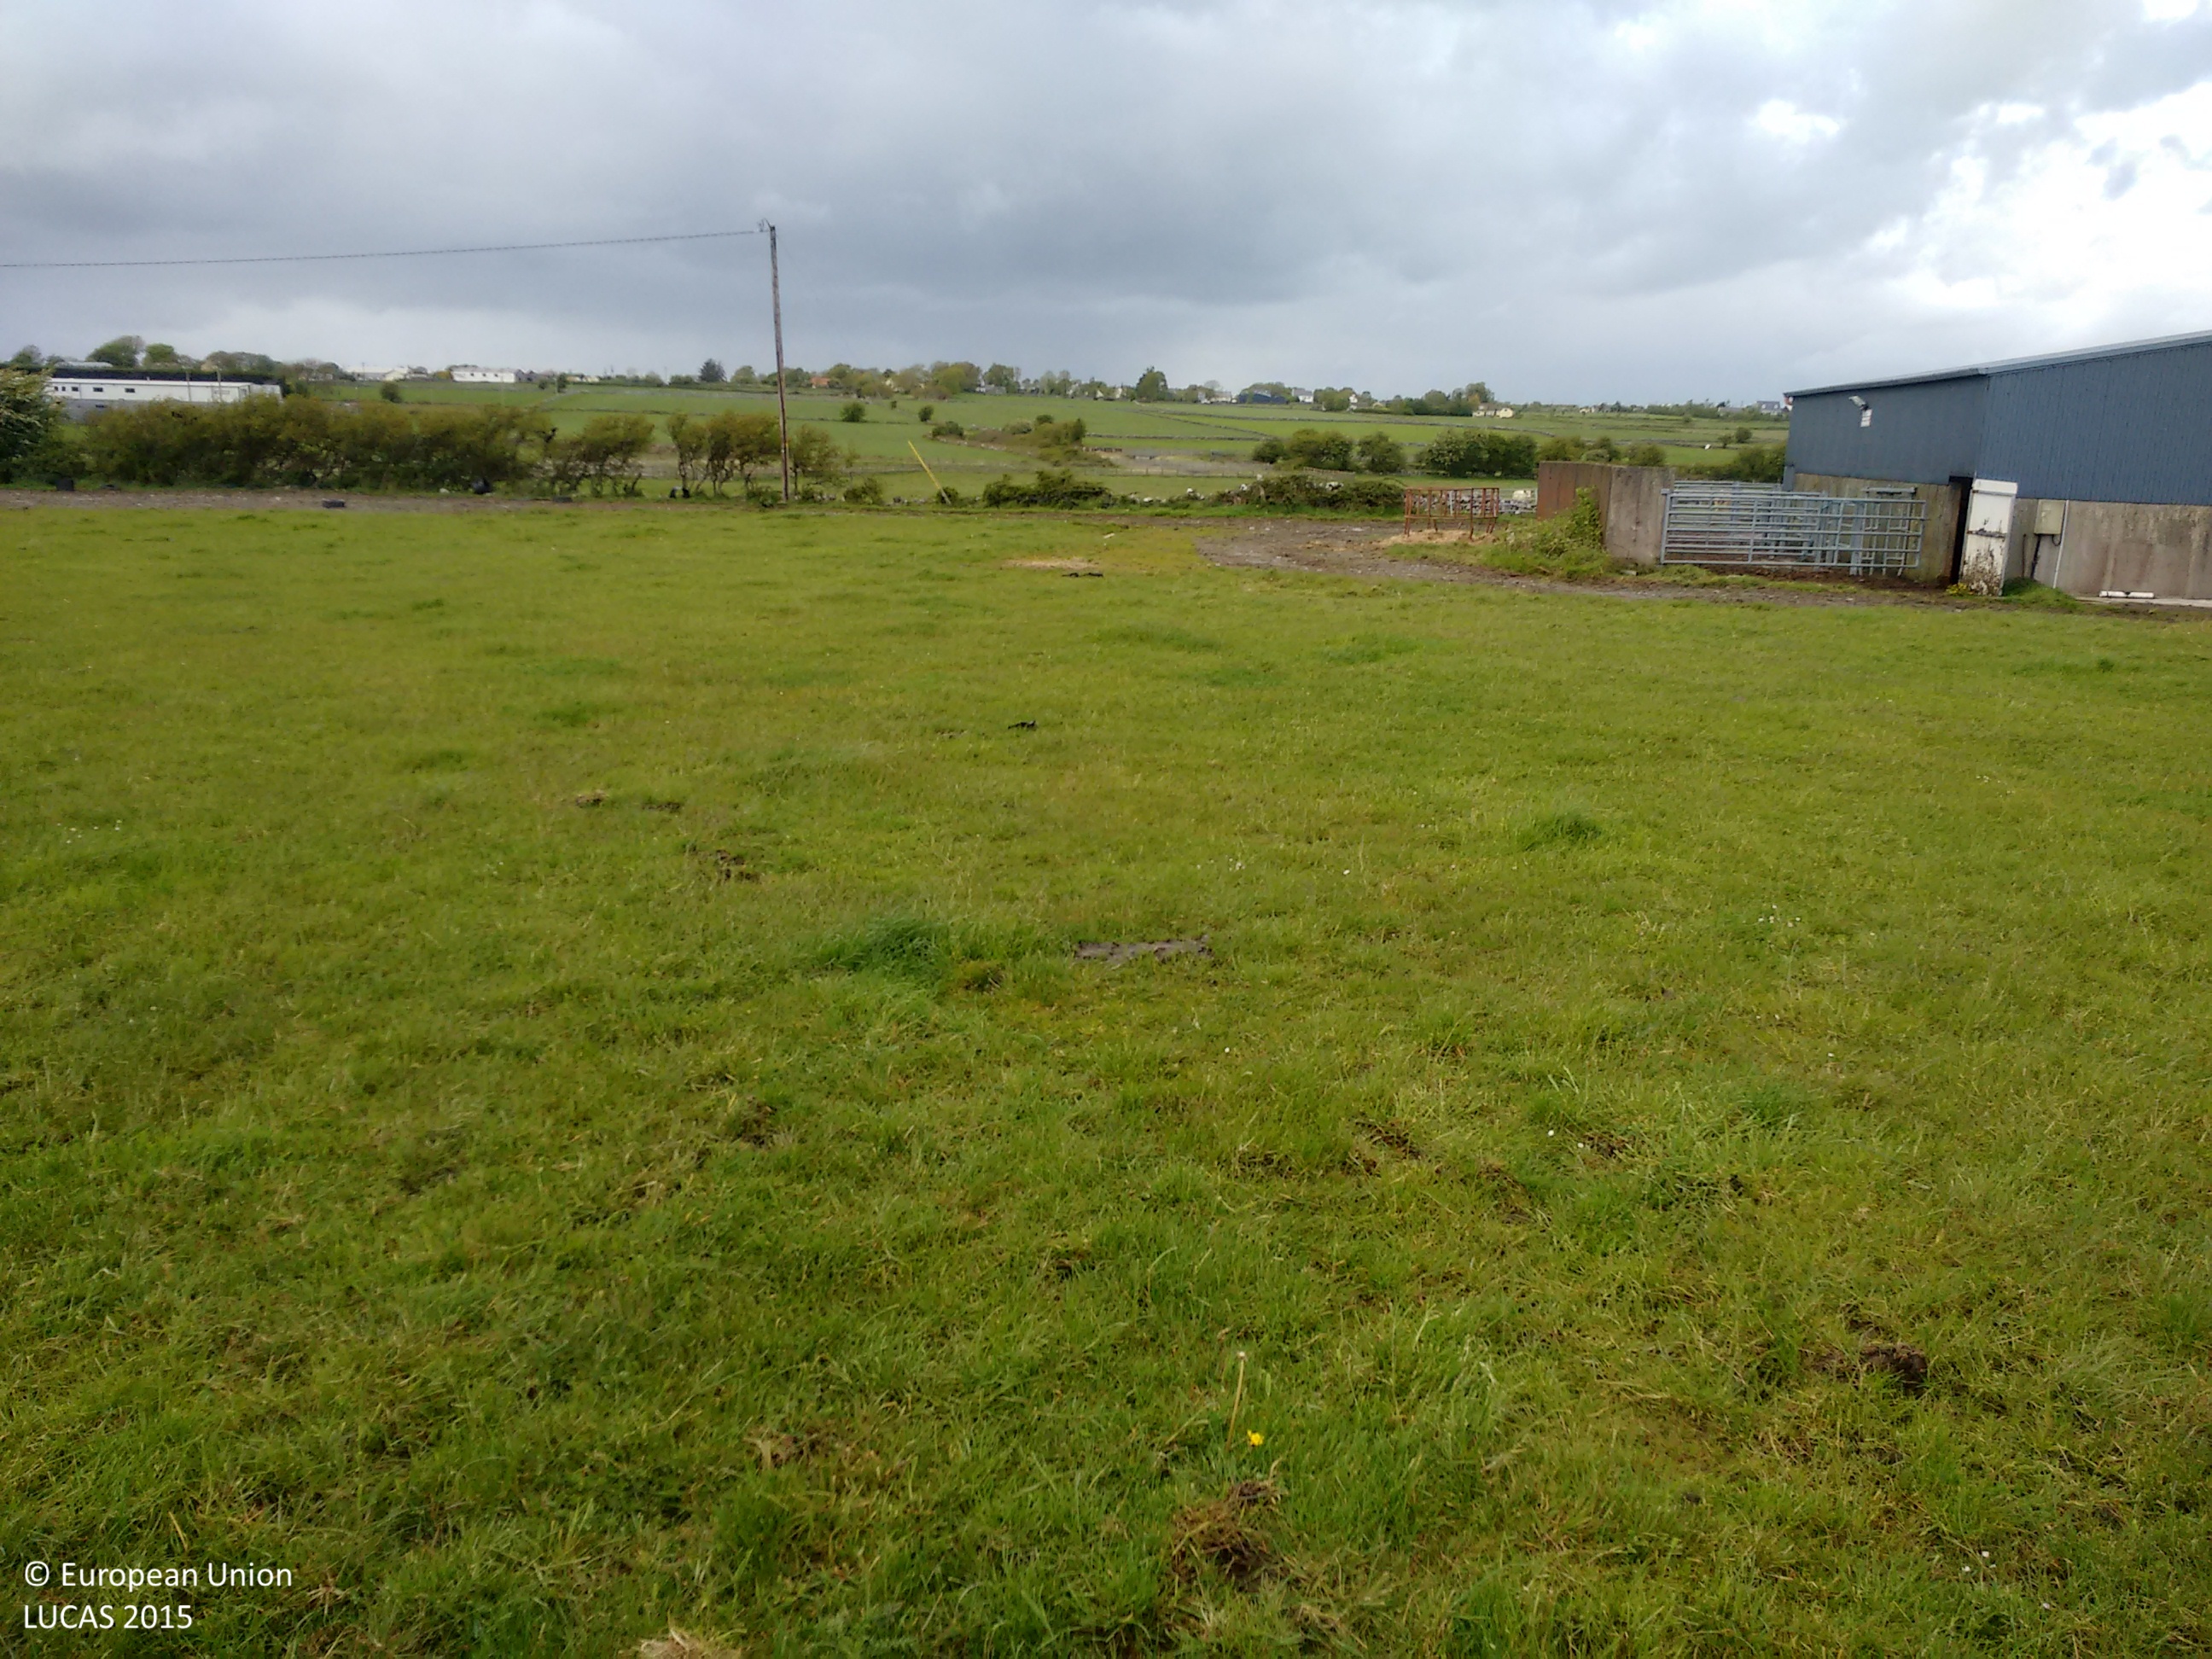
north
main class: Grassland
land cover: Grassland without tree/shrub cover
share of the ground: > 75 %
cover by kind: herbaceous plants 95 %, consolidated bare surface 5 %
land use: Agriculture (excluding fallow land and kitchen gardens)
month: May
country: IE
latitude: 53.2961
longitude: -8.9188
